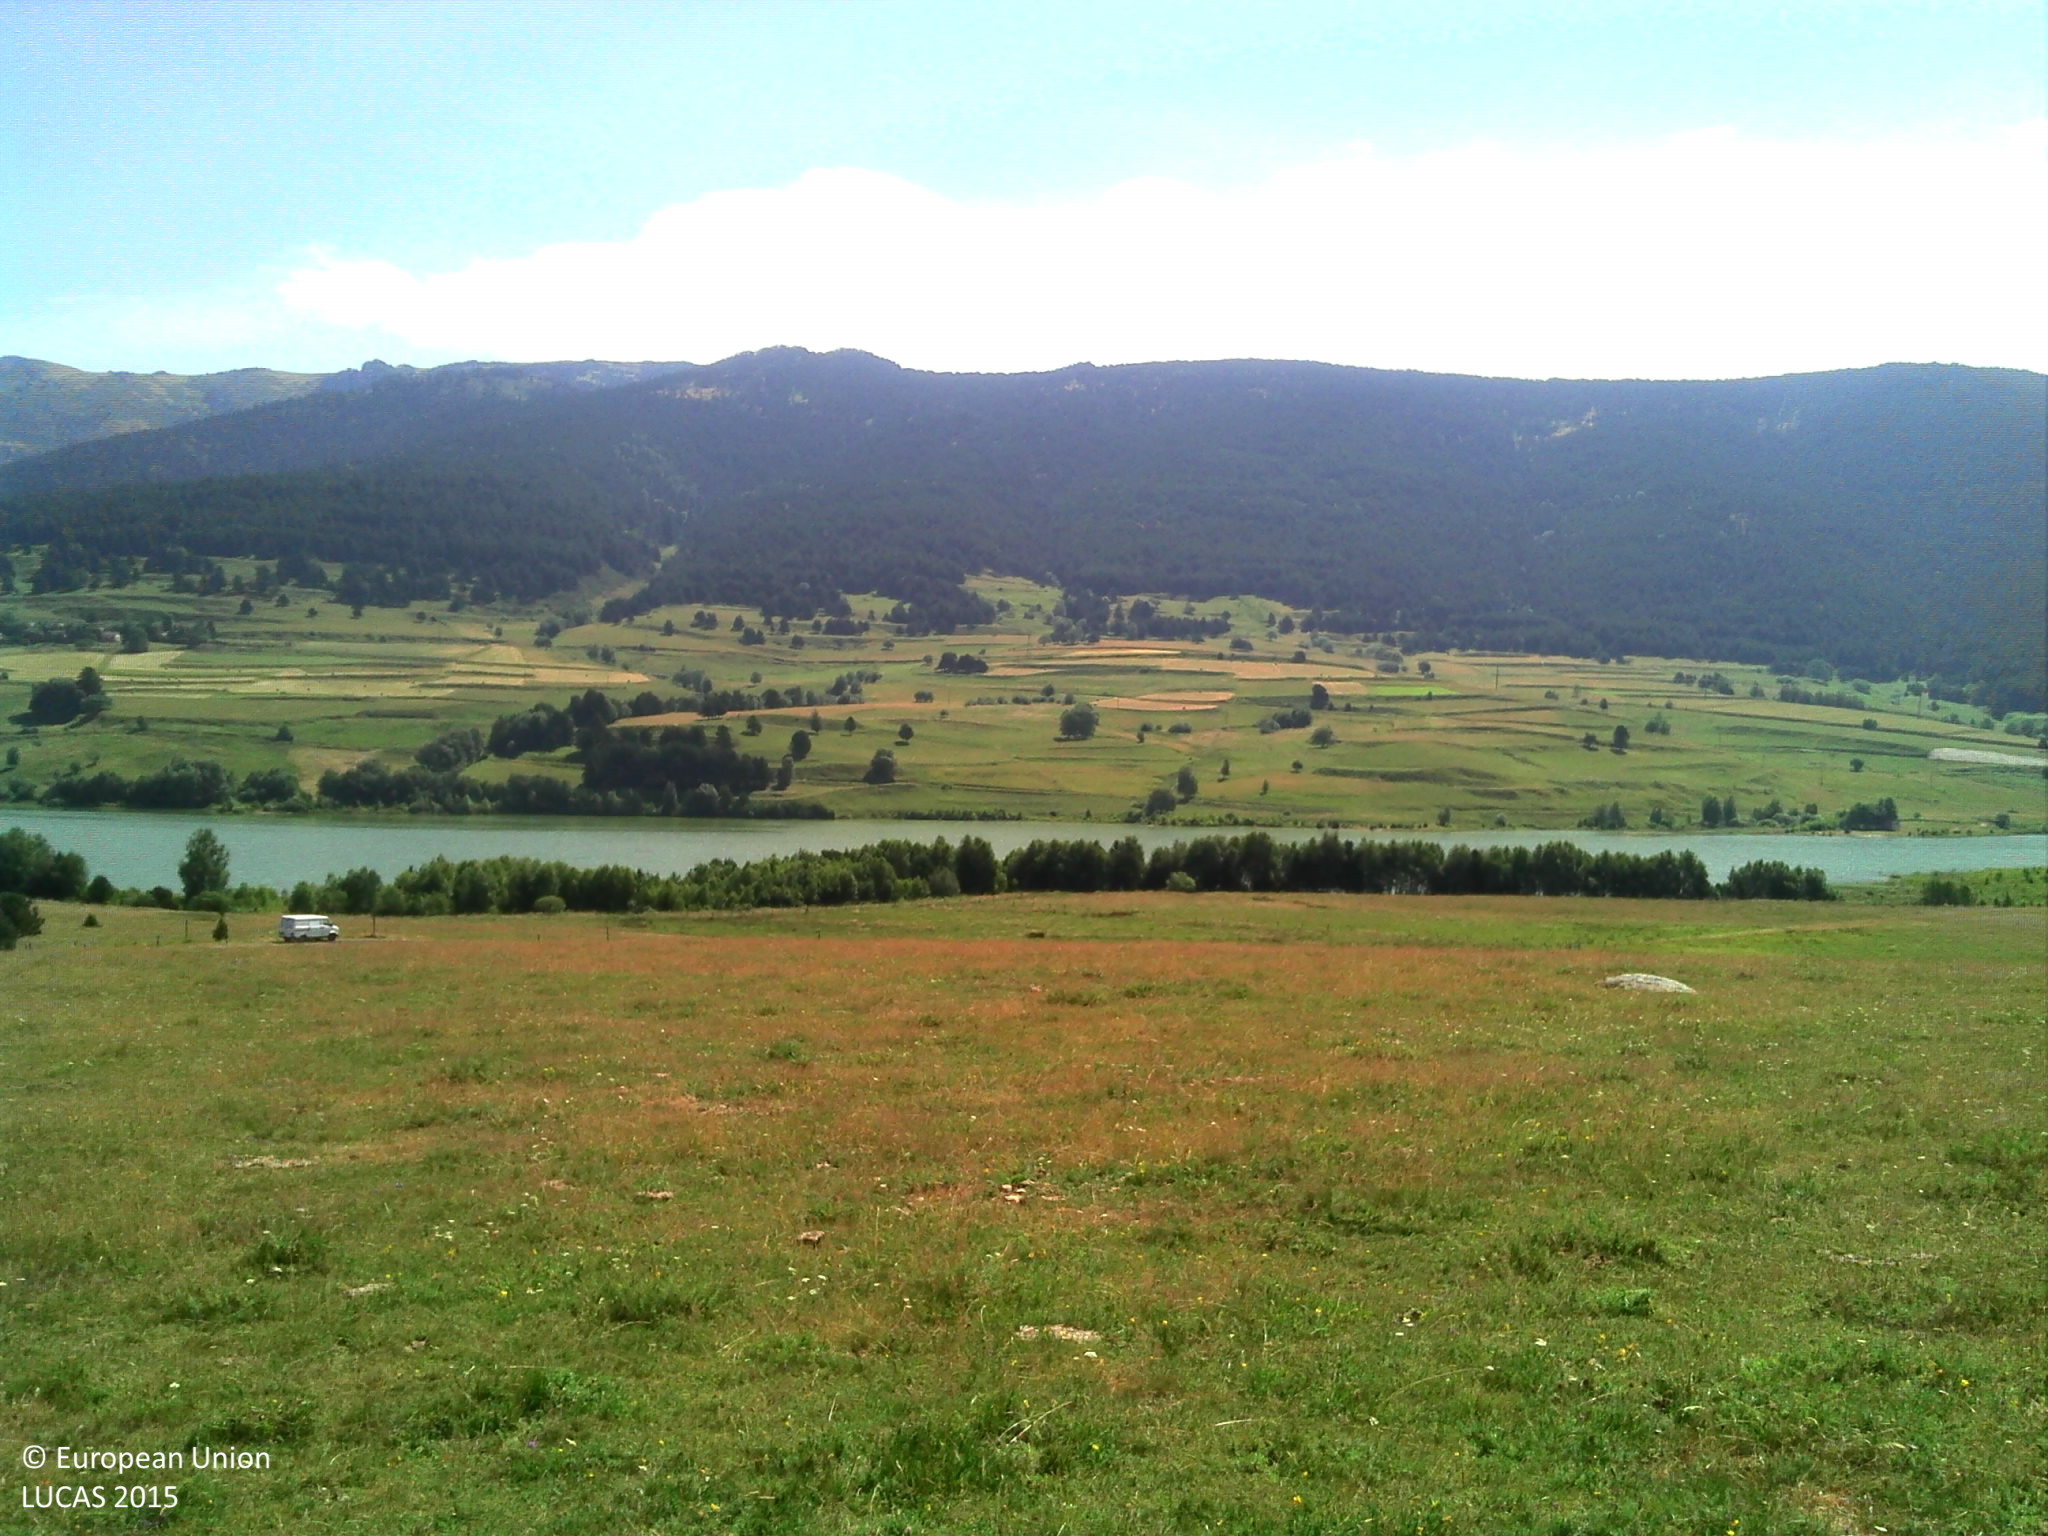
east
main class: Grassland
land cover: Grassland without tree/shrub cover
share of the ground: > 75 %
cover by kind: herbaceous plants 100 %
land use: Agriculture (excluding fallow land and kitchen gardens)
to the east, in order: Grassland without tree/shrub cover; Fences; Grass margins; Ditches and canals; Grass margins; Paved roads, cycling and walking lanes; Grass margins; Tracks; Fences; Grassland without tree/shrub cover; Tracks; Grassland without tree/shrub cover
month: July
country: FR
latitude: 42.6369
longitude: 2.1202
